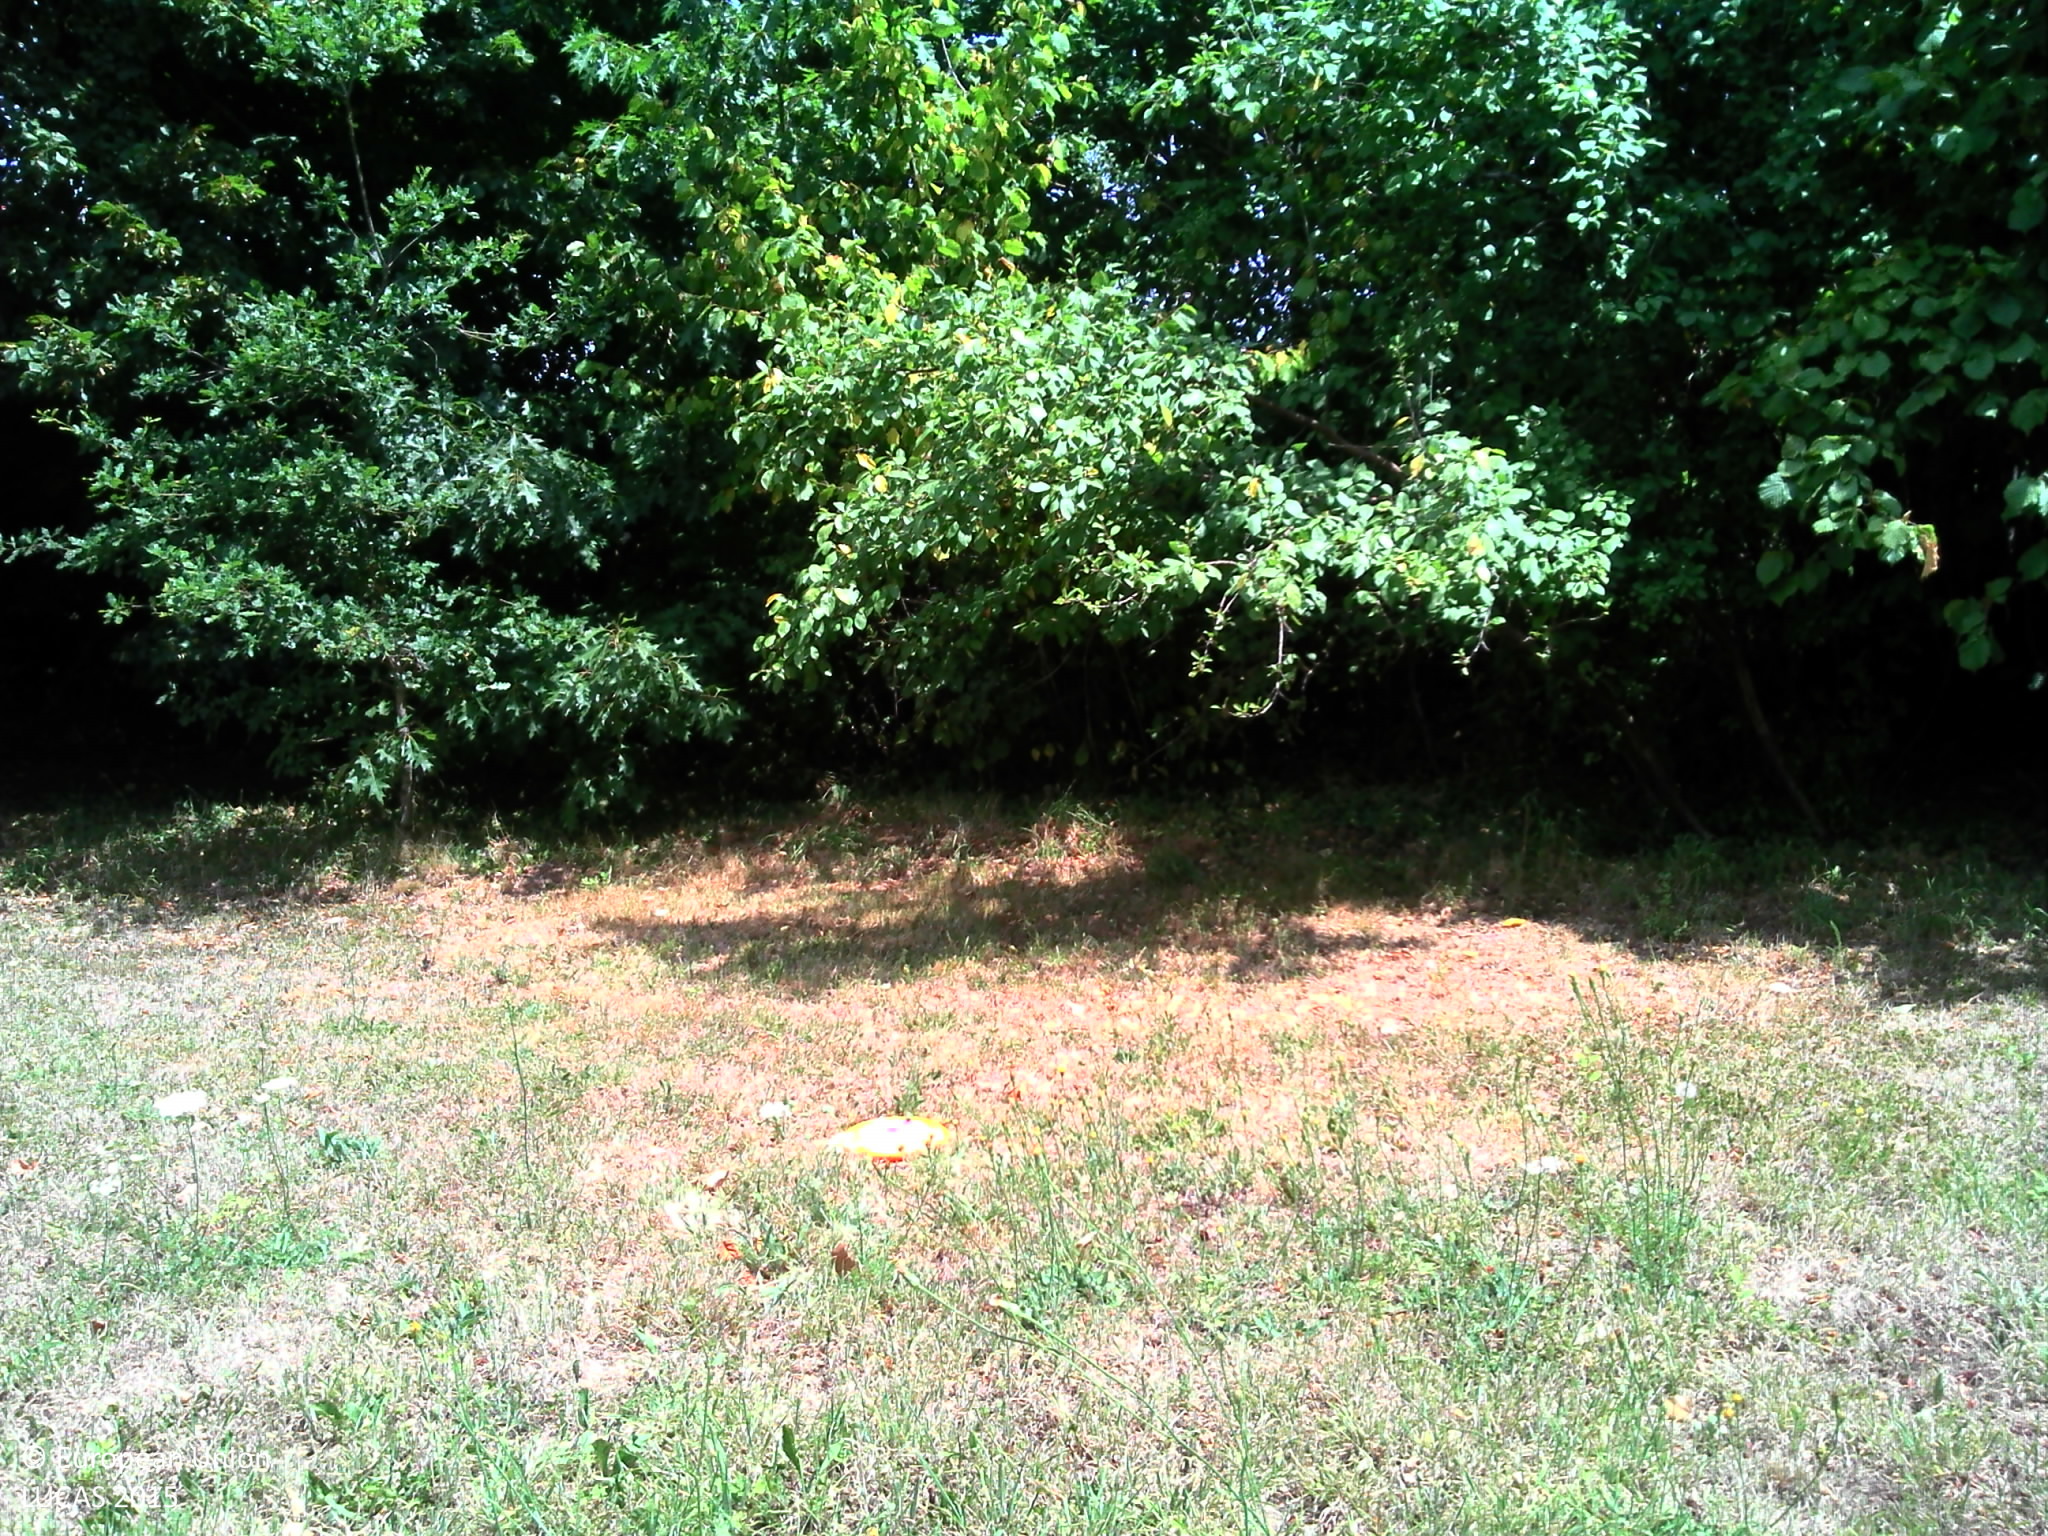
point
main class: Grassland
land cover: Grassland without tree/shrub cover
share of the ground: > 75 %
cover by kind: herbaceous plants 95 %
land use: Residential
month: July
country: FR
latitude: 45.7004
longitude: 1.0123
